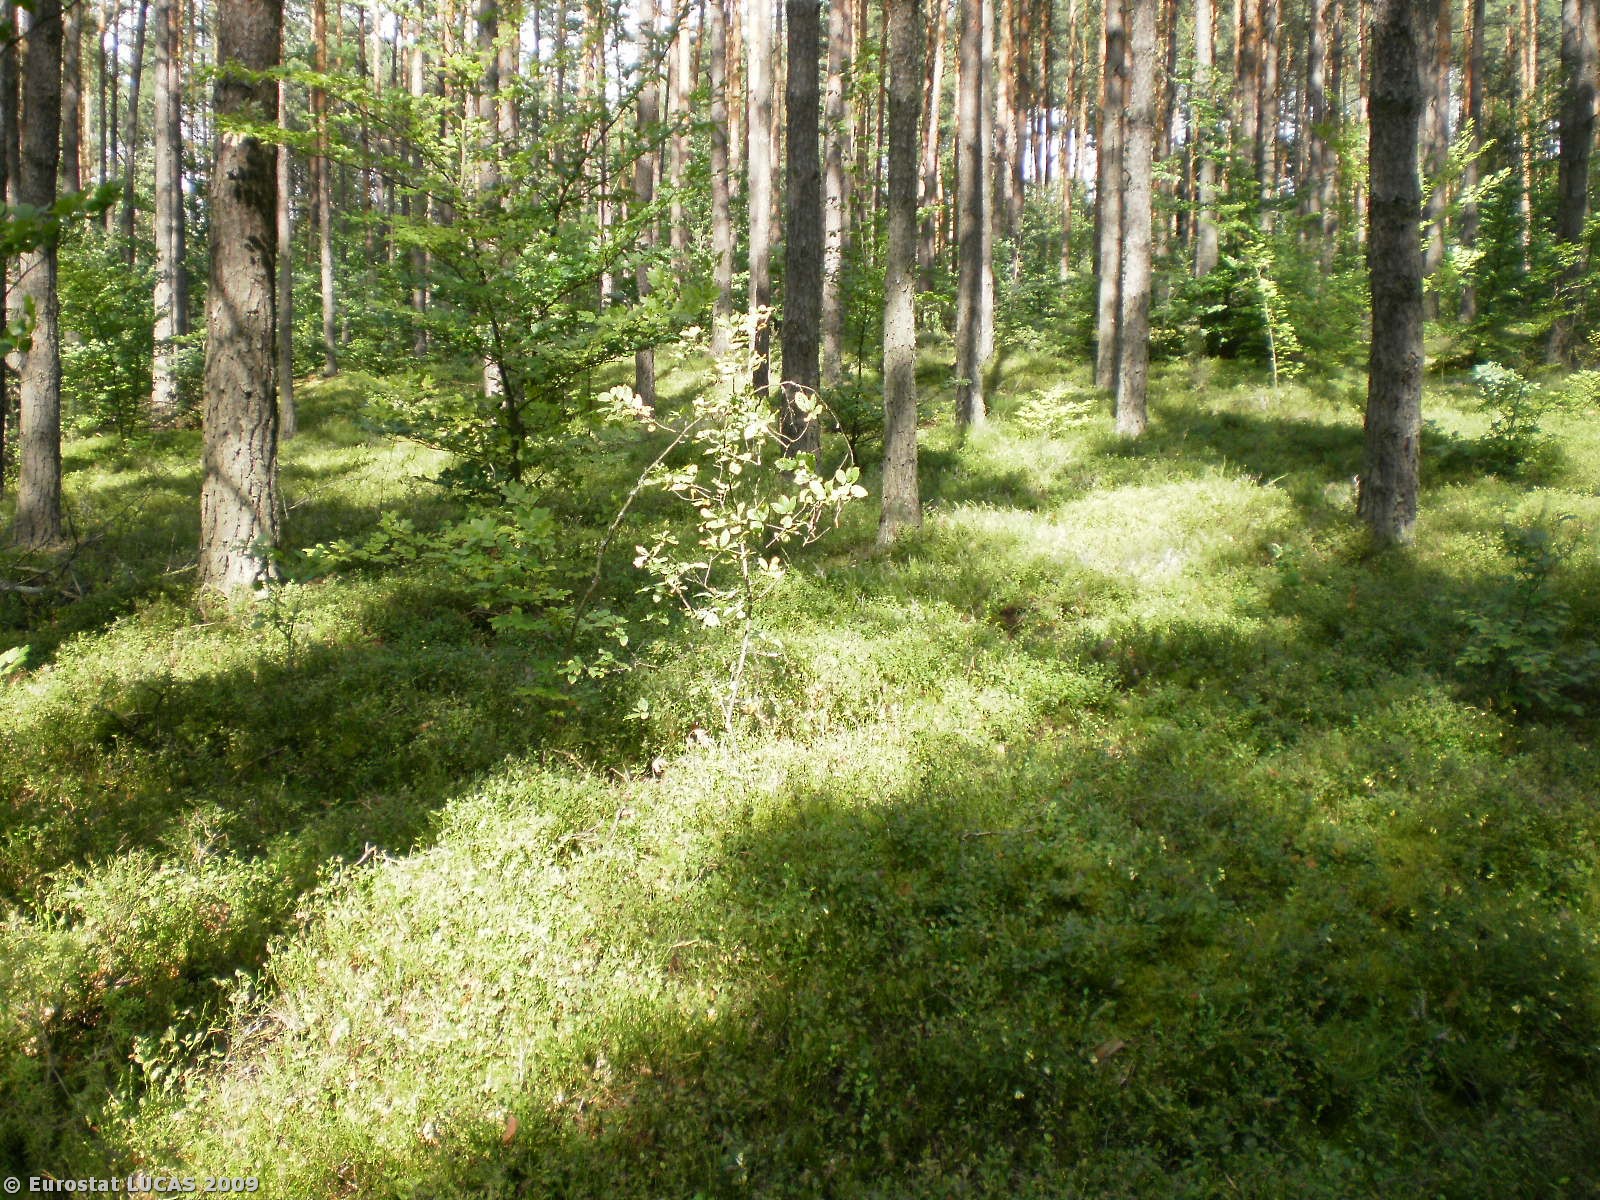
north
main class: Woodland
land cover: Coniferous woodland
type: hemiboreal forest and nemoral coniferous forest and mixed broadleaved-coniferous forest
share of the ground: > 75 %
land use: Forestry
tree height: > 5 m
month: August
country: PL
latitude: 52.7377
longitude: 21.7400
